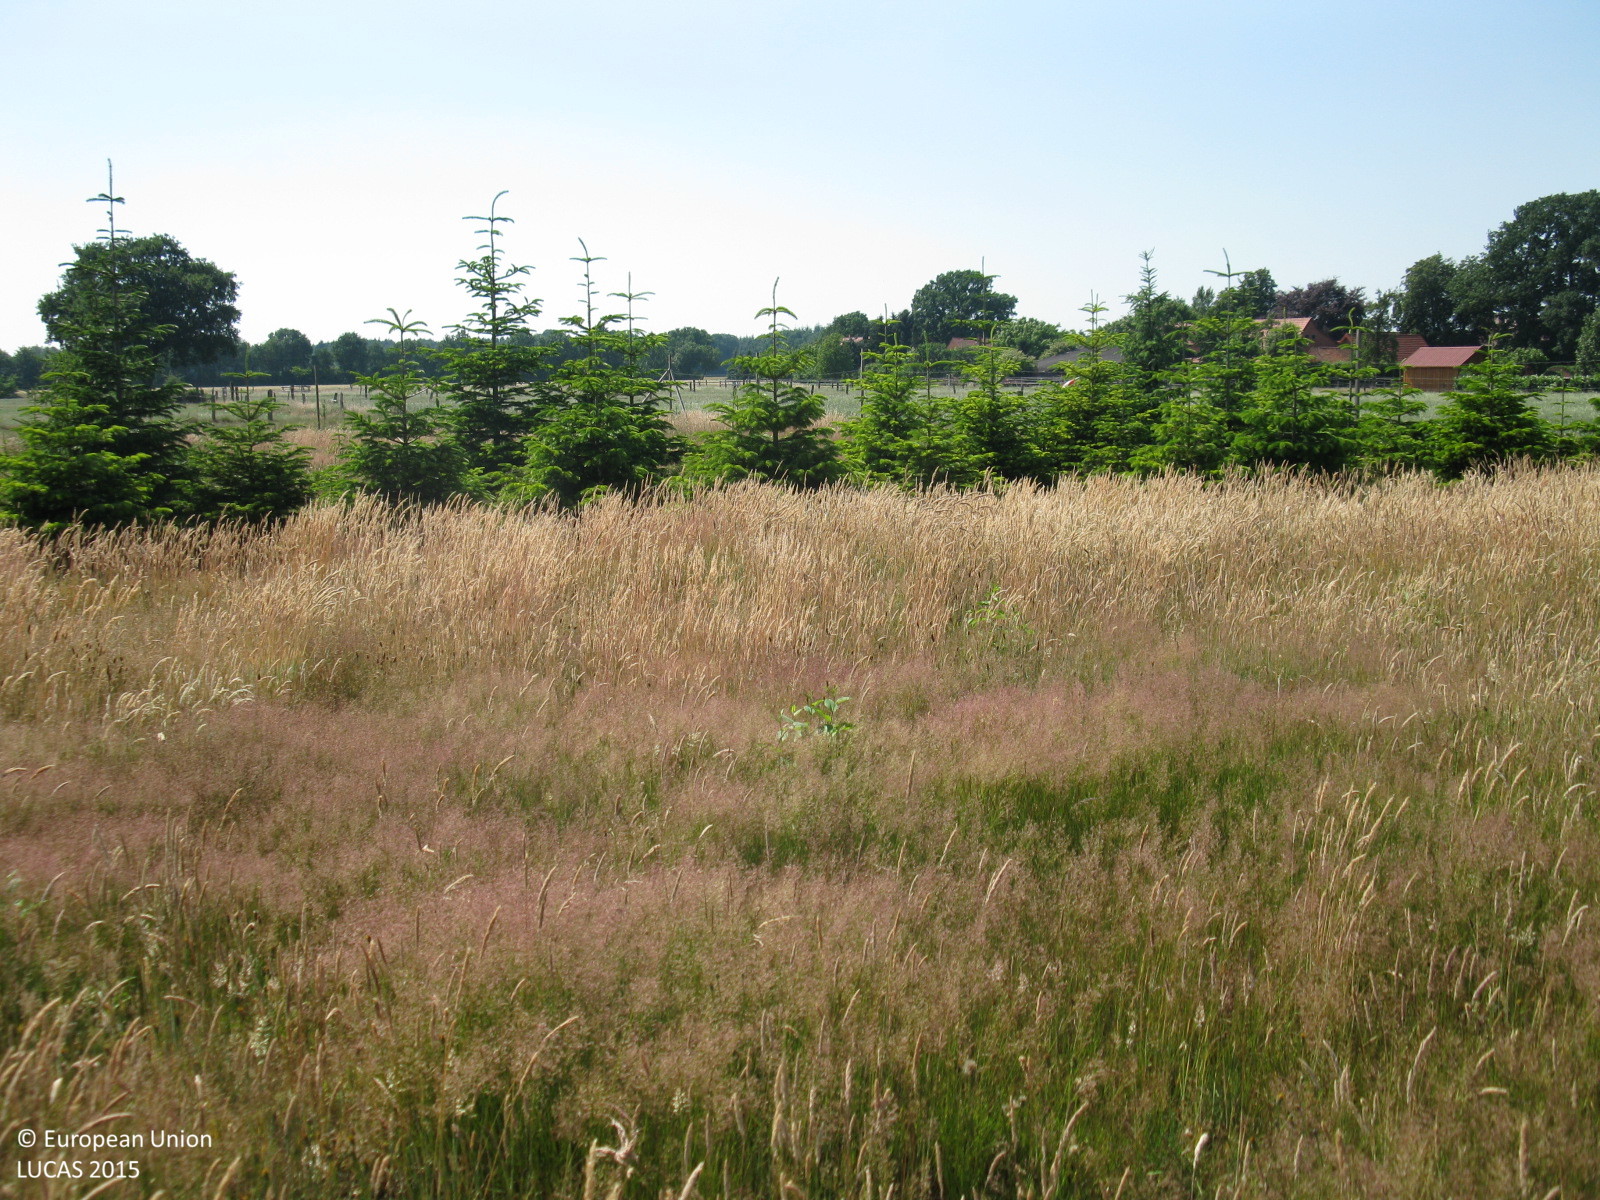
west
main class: Grassland
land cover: Spontaneously vegetated surfaces
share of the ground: > 75 %
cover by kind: herbaceous plants 100 %
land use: Agriculture (excluding fallow land and kitchen gardens)
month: July
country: DE
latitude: 52.9132
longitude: 9.0932
